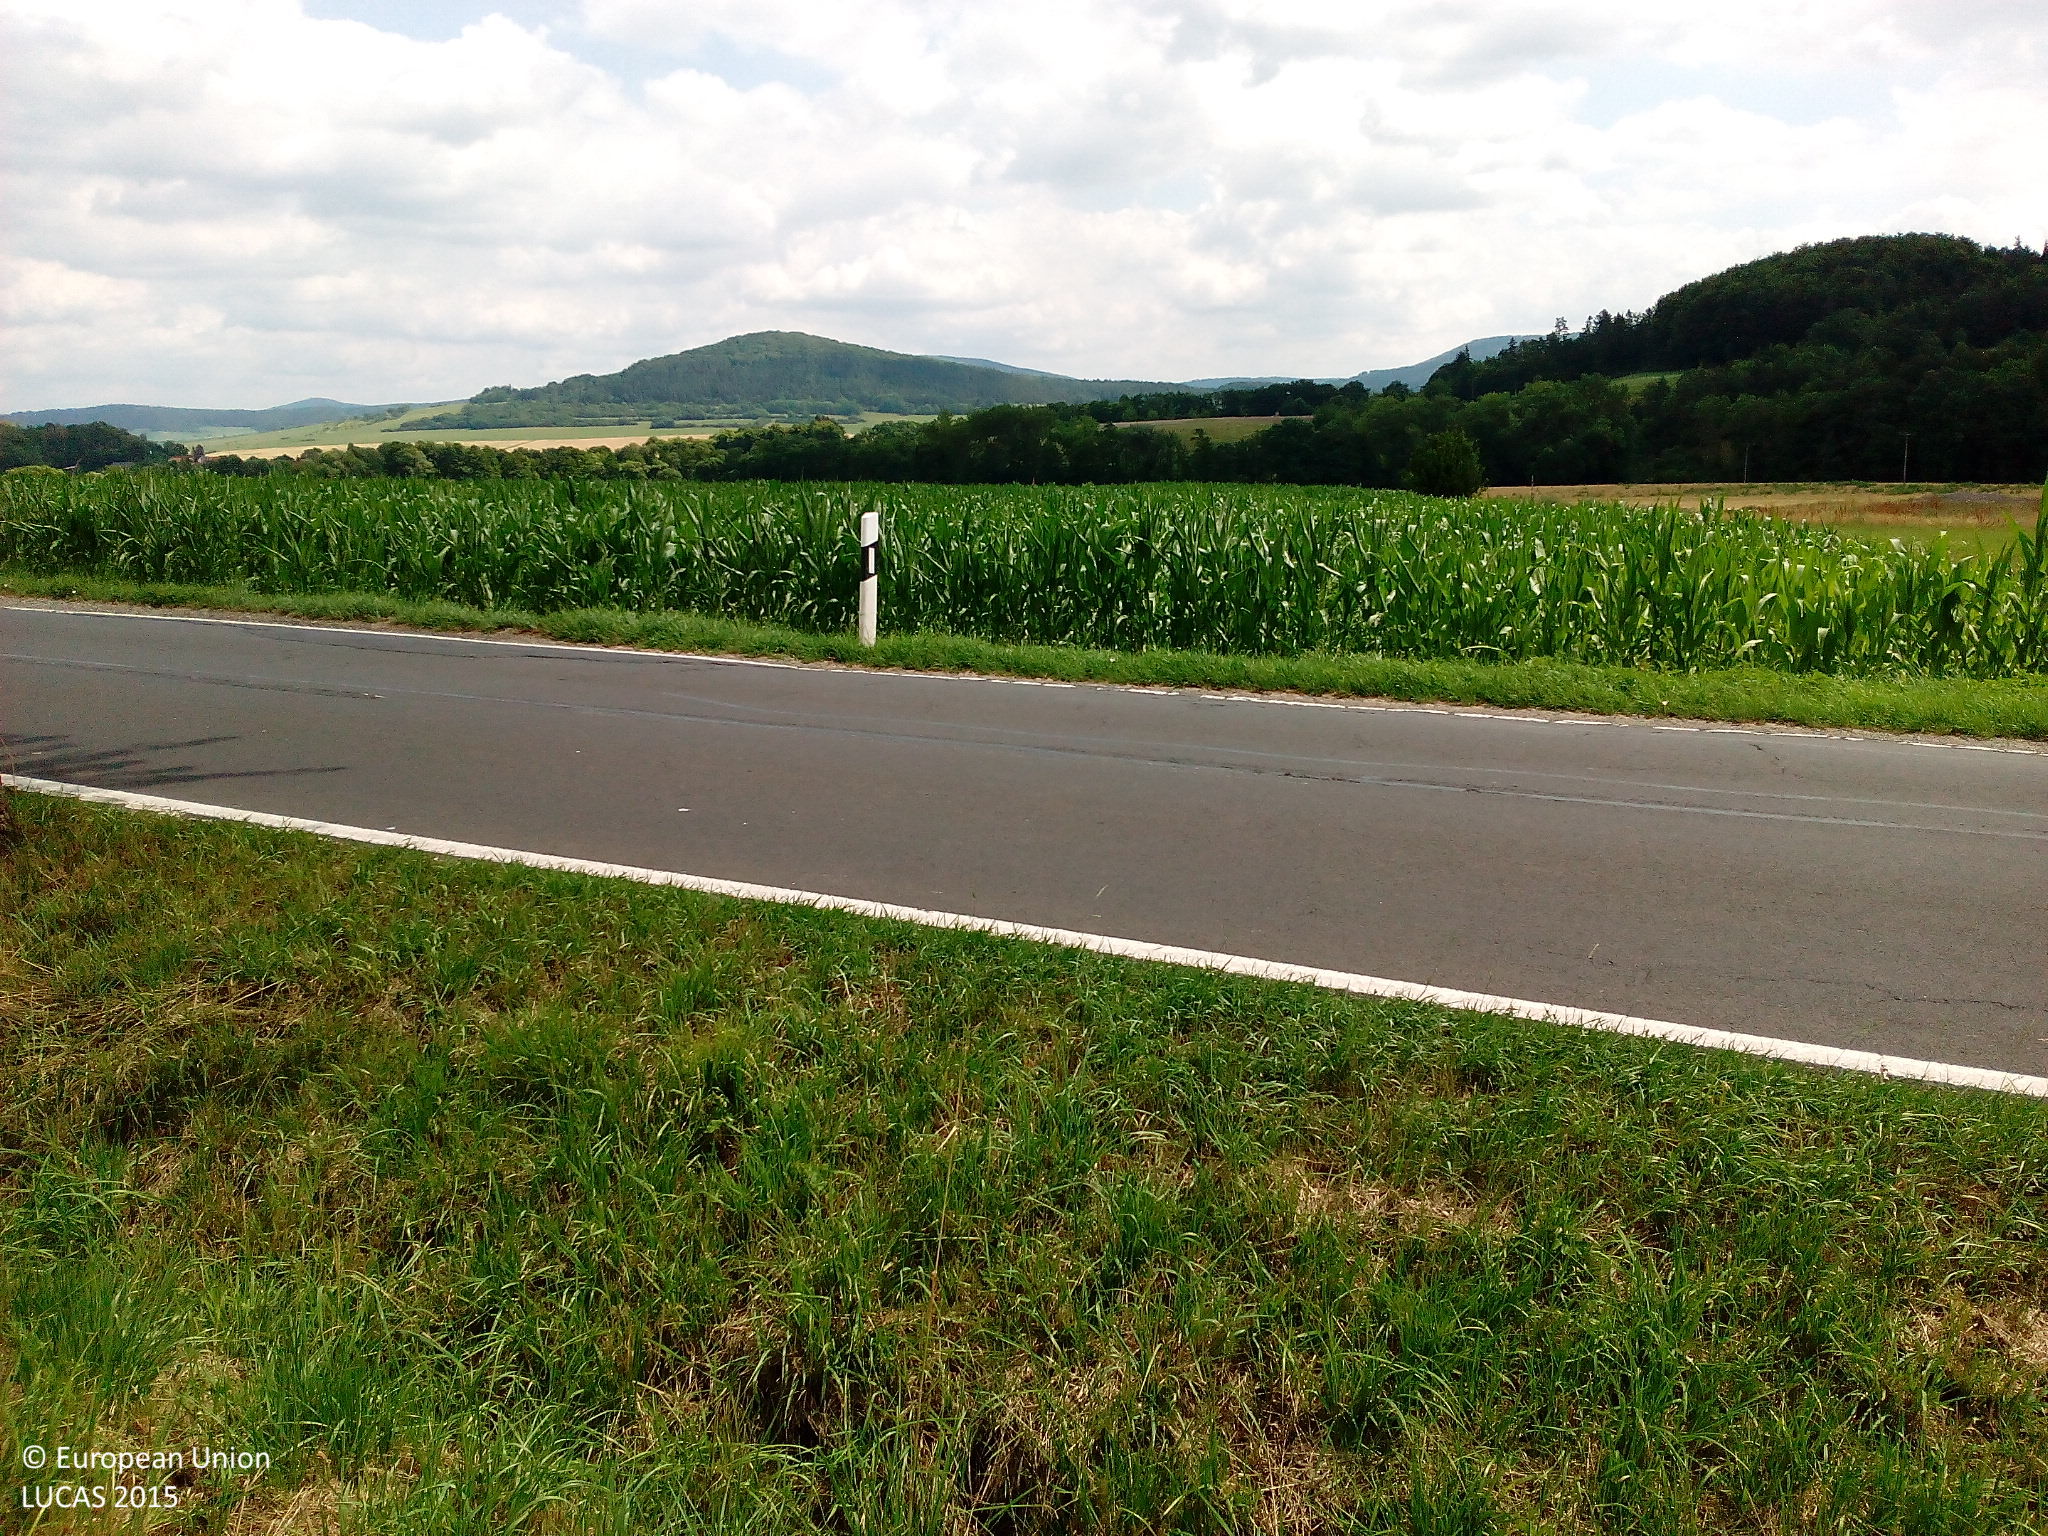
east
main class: Cropland
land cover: Barley
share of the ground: > 75 %
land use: Agriculture (excluding fallow land and kitchen gardens)
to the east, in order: Barley; Grass margins; Paved roads, cycling and walking lanes; Grass margins; Maize
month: July
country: DE
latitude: 50.7056
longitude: 9.9292
